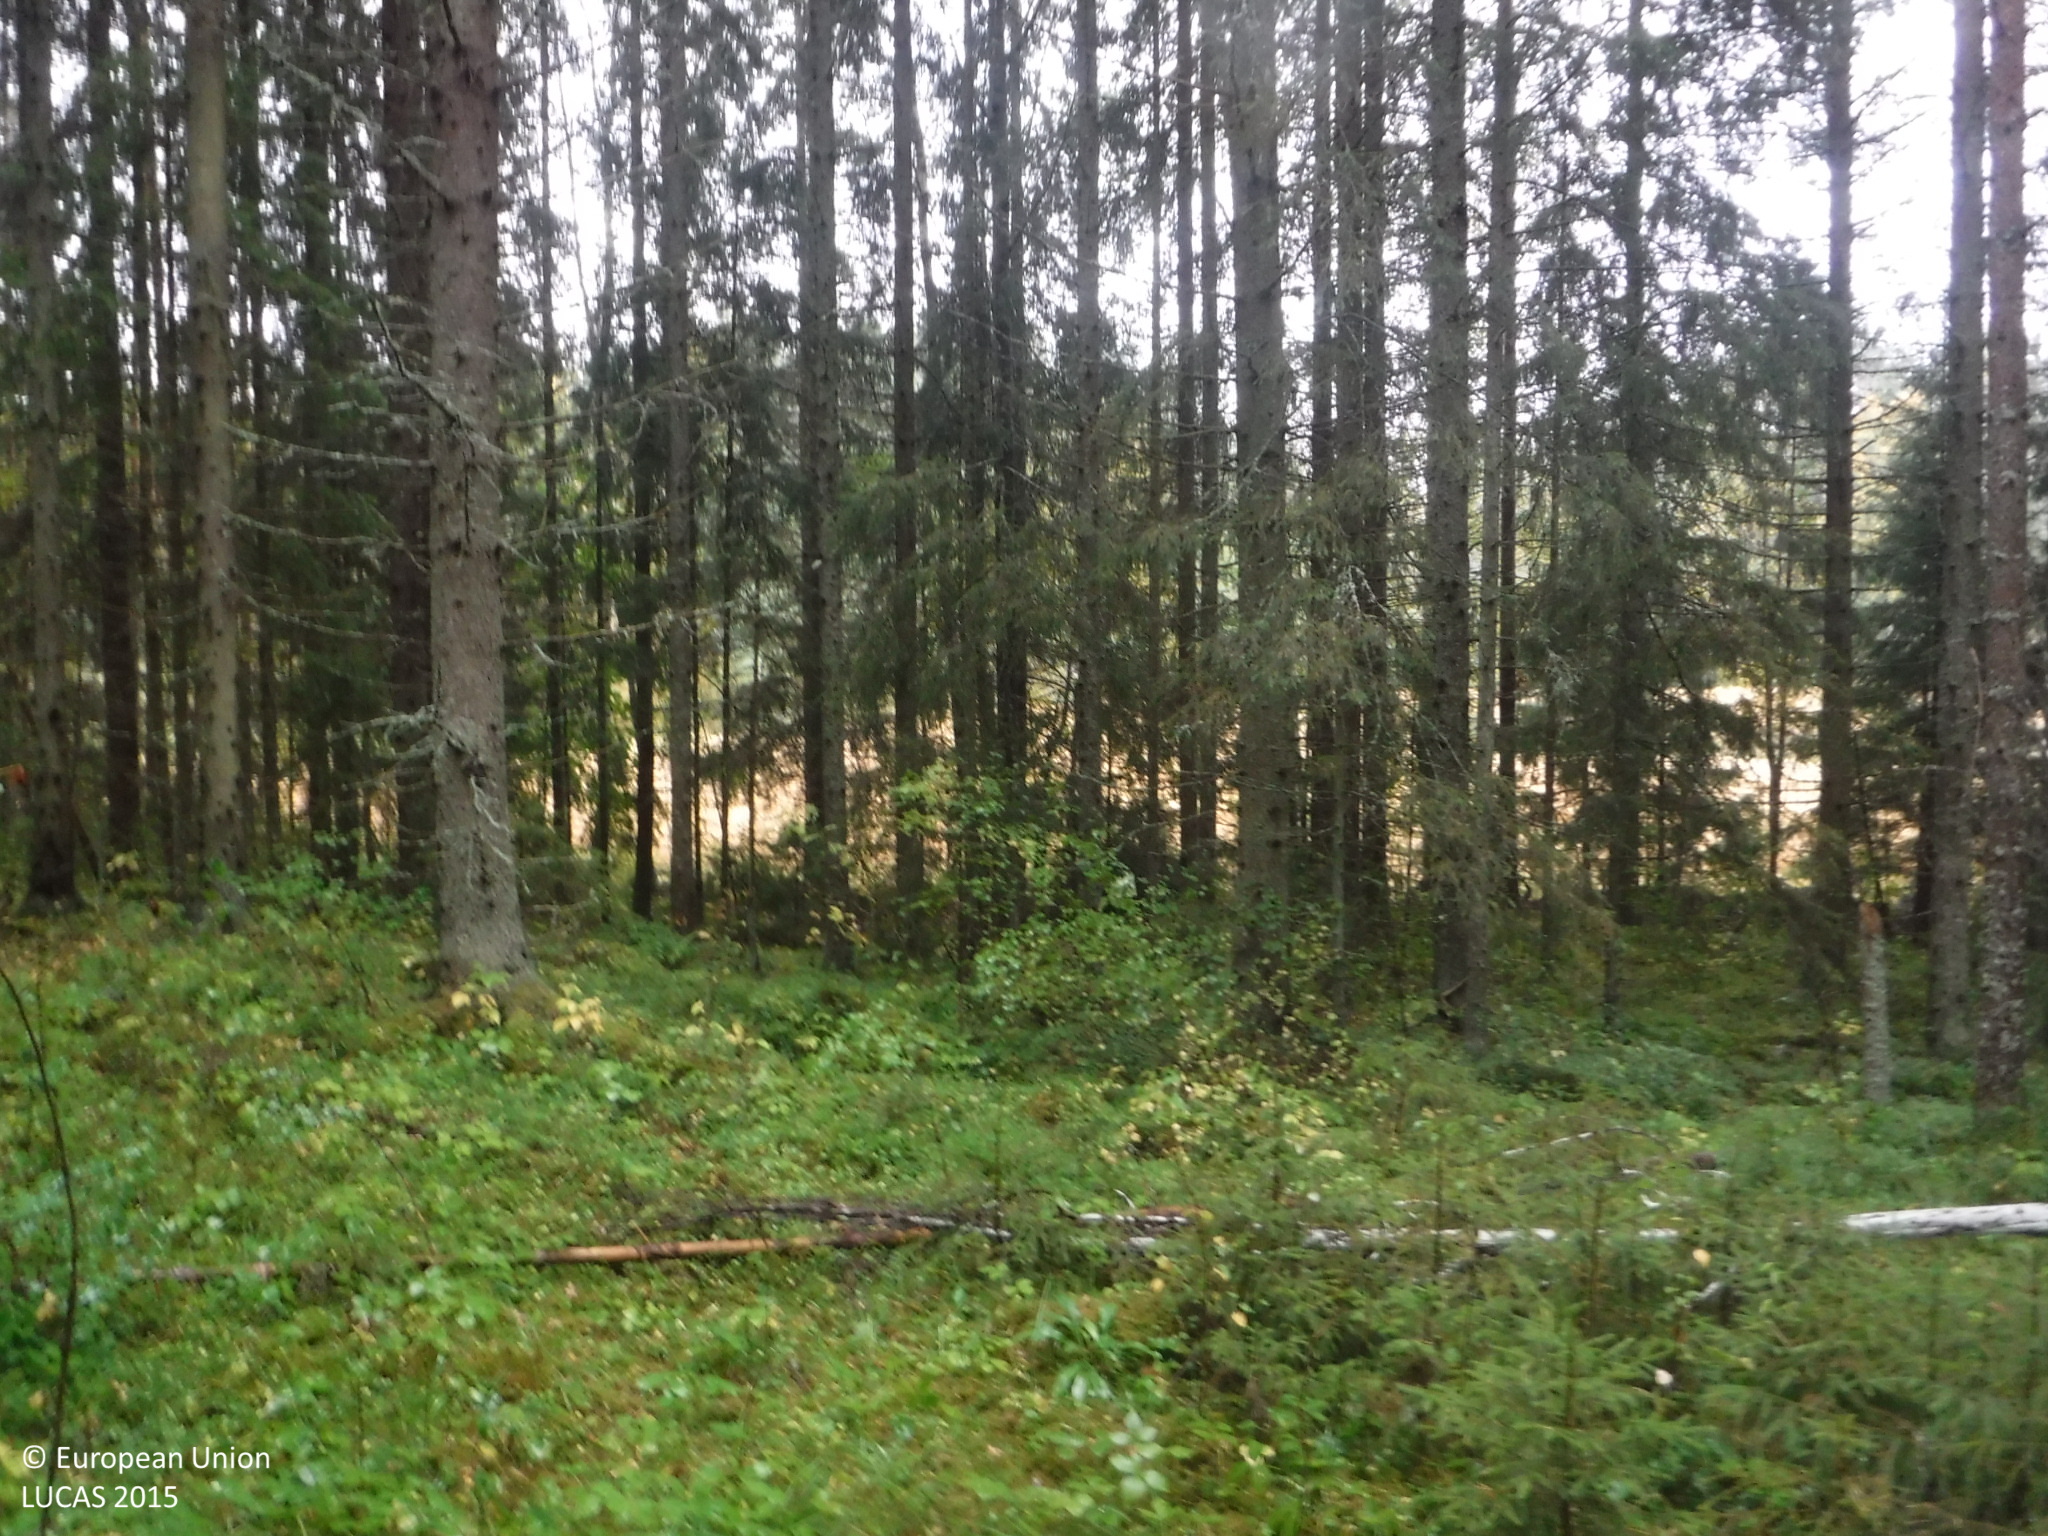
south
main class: Woodland
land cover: Other coniferous woodland
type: boreal forest
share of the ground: > 75 %
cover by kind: coniferous forest trees 80 %, lichens and mosses 15 %, herbaceous plants 5 %
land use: Forestry
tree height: > 5 m
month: September
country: FI
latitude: 61.7589
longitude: 21.6251
